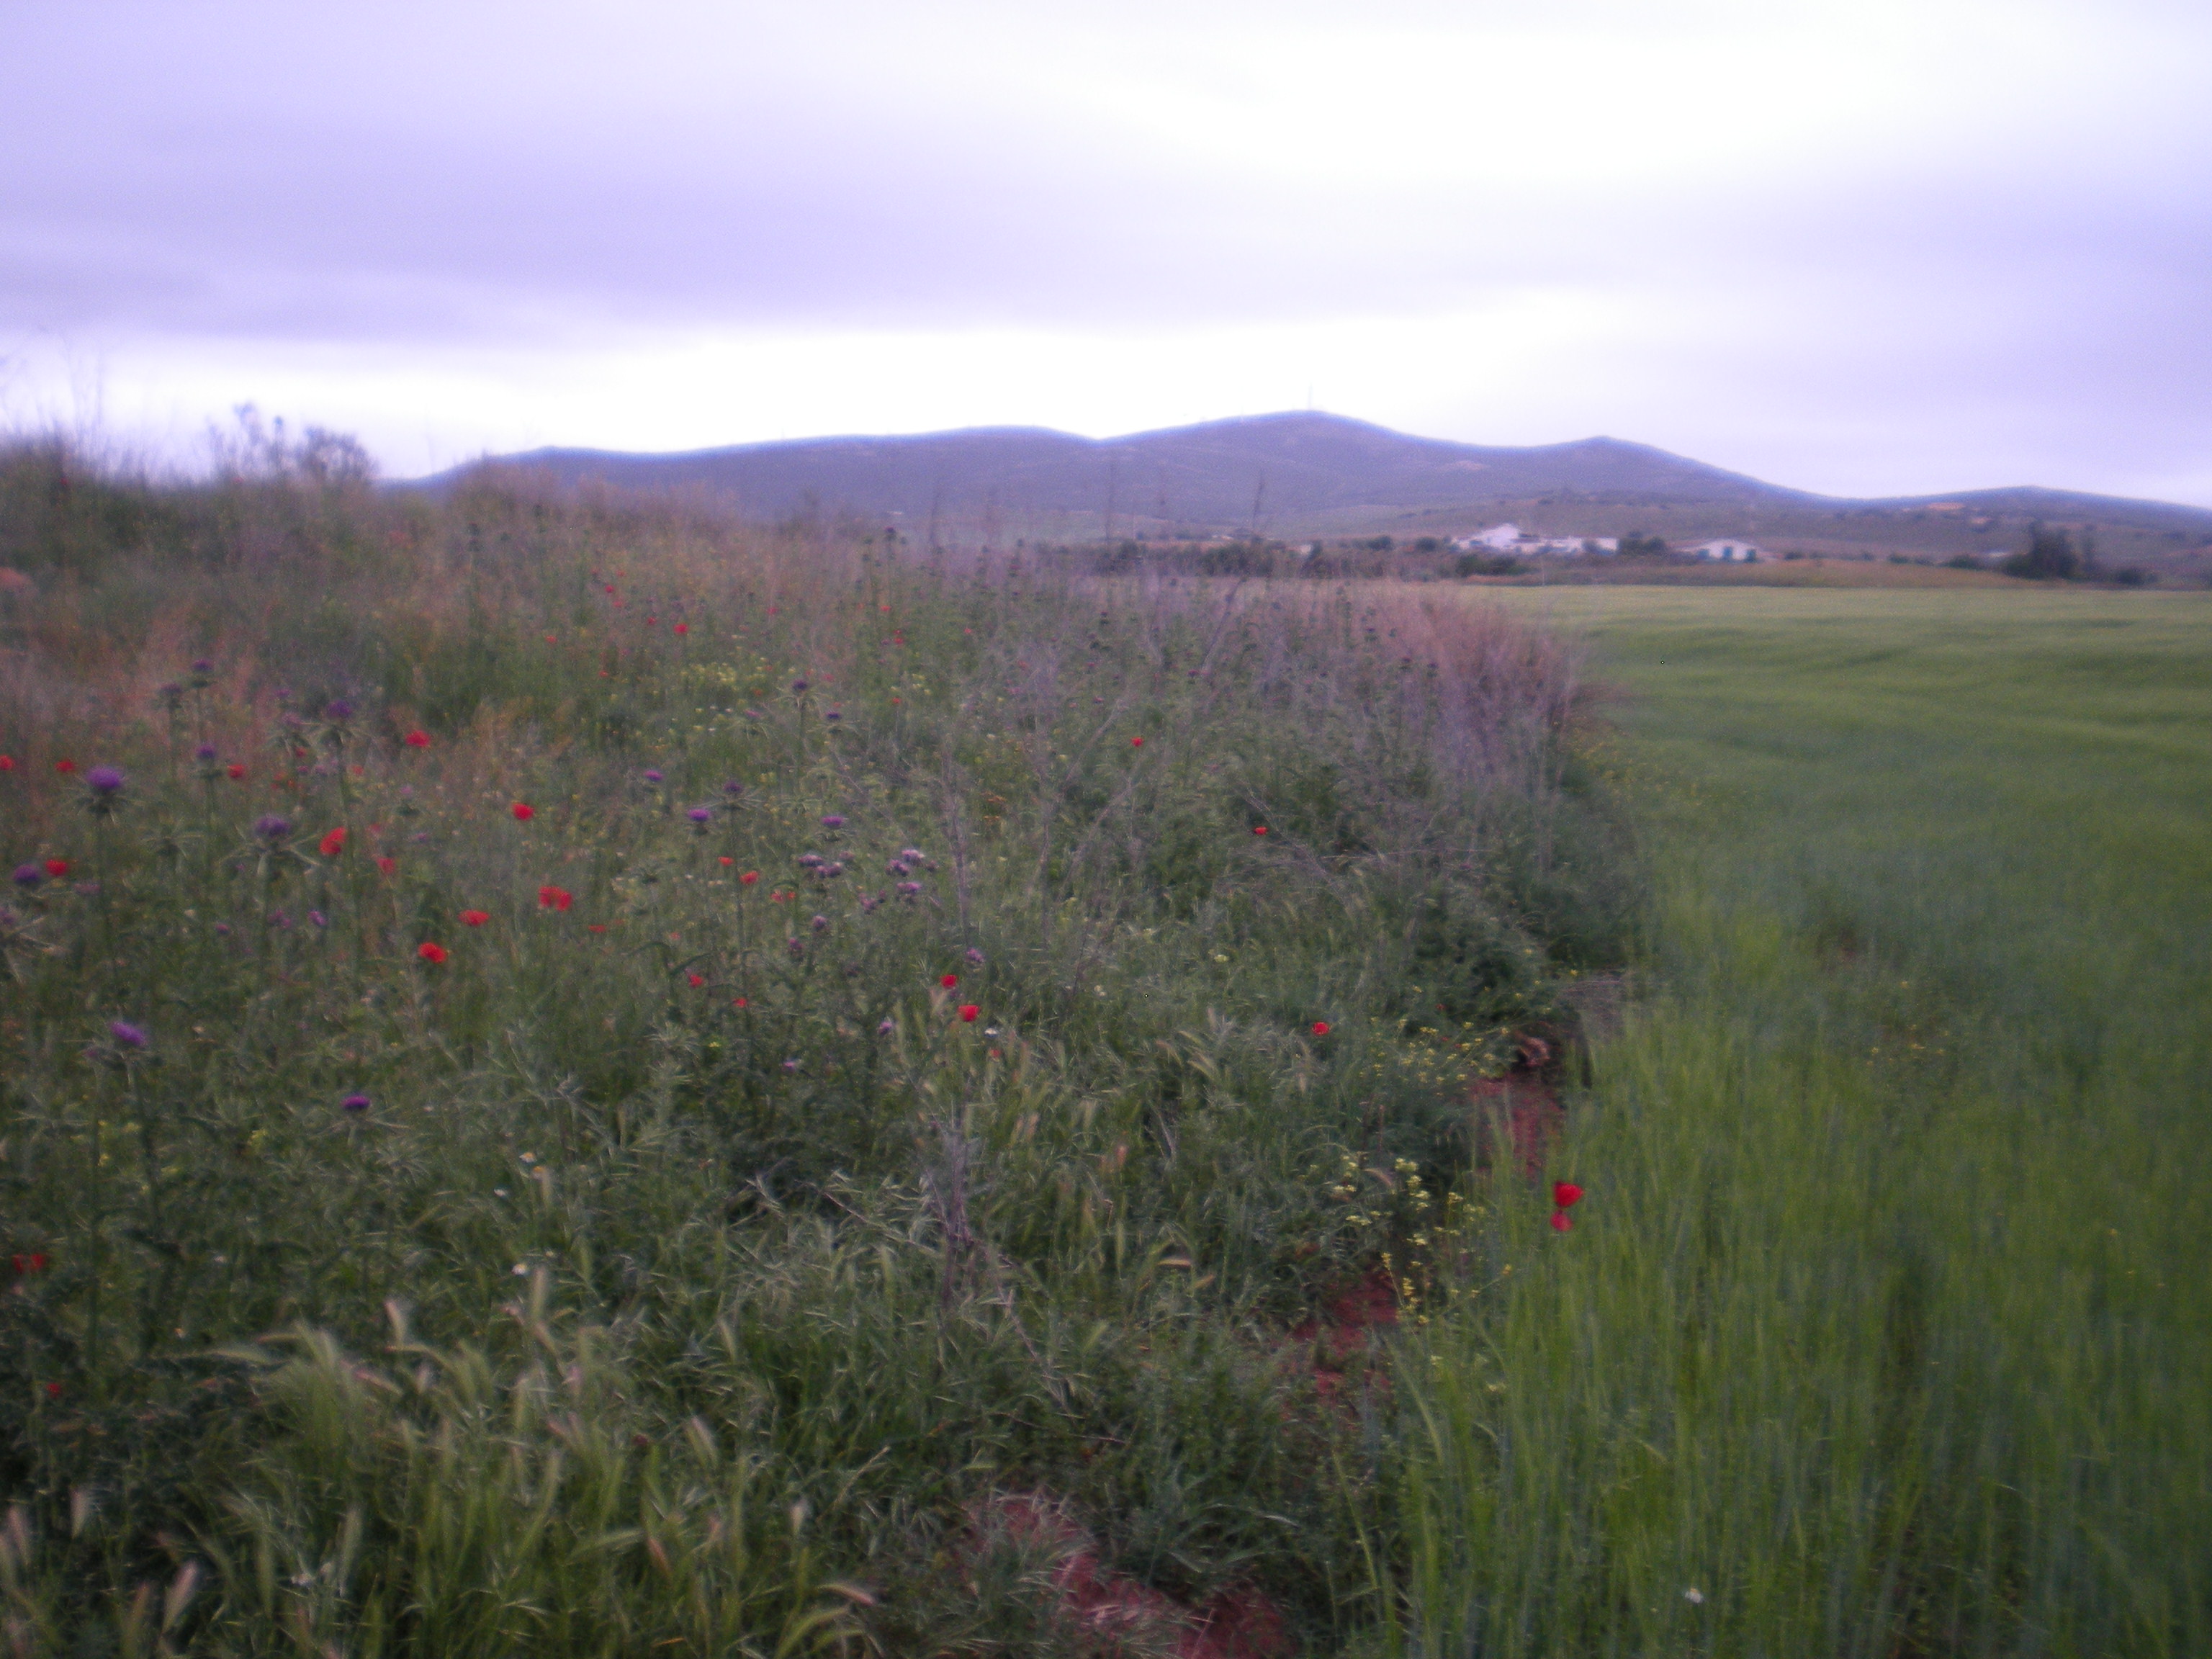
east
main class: Cropland
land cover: Barley
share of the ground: > 75 %
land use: Agriculture (excluding fallow land and kitchen gardens)
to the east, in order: Barley
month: May
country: ES
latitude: 38.8786
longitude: -3.1859
